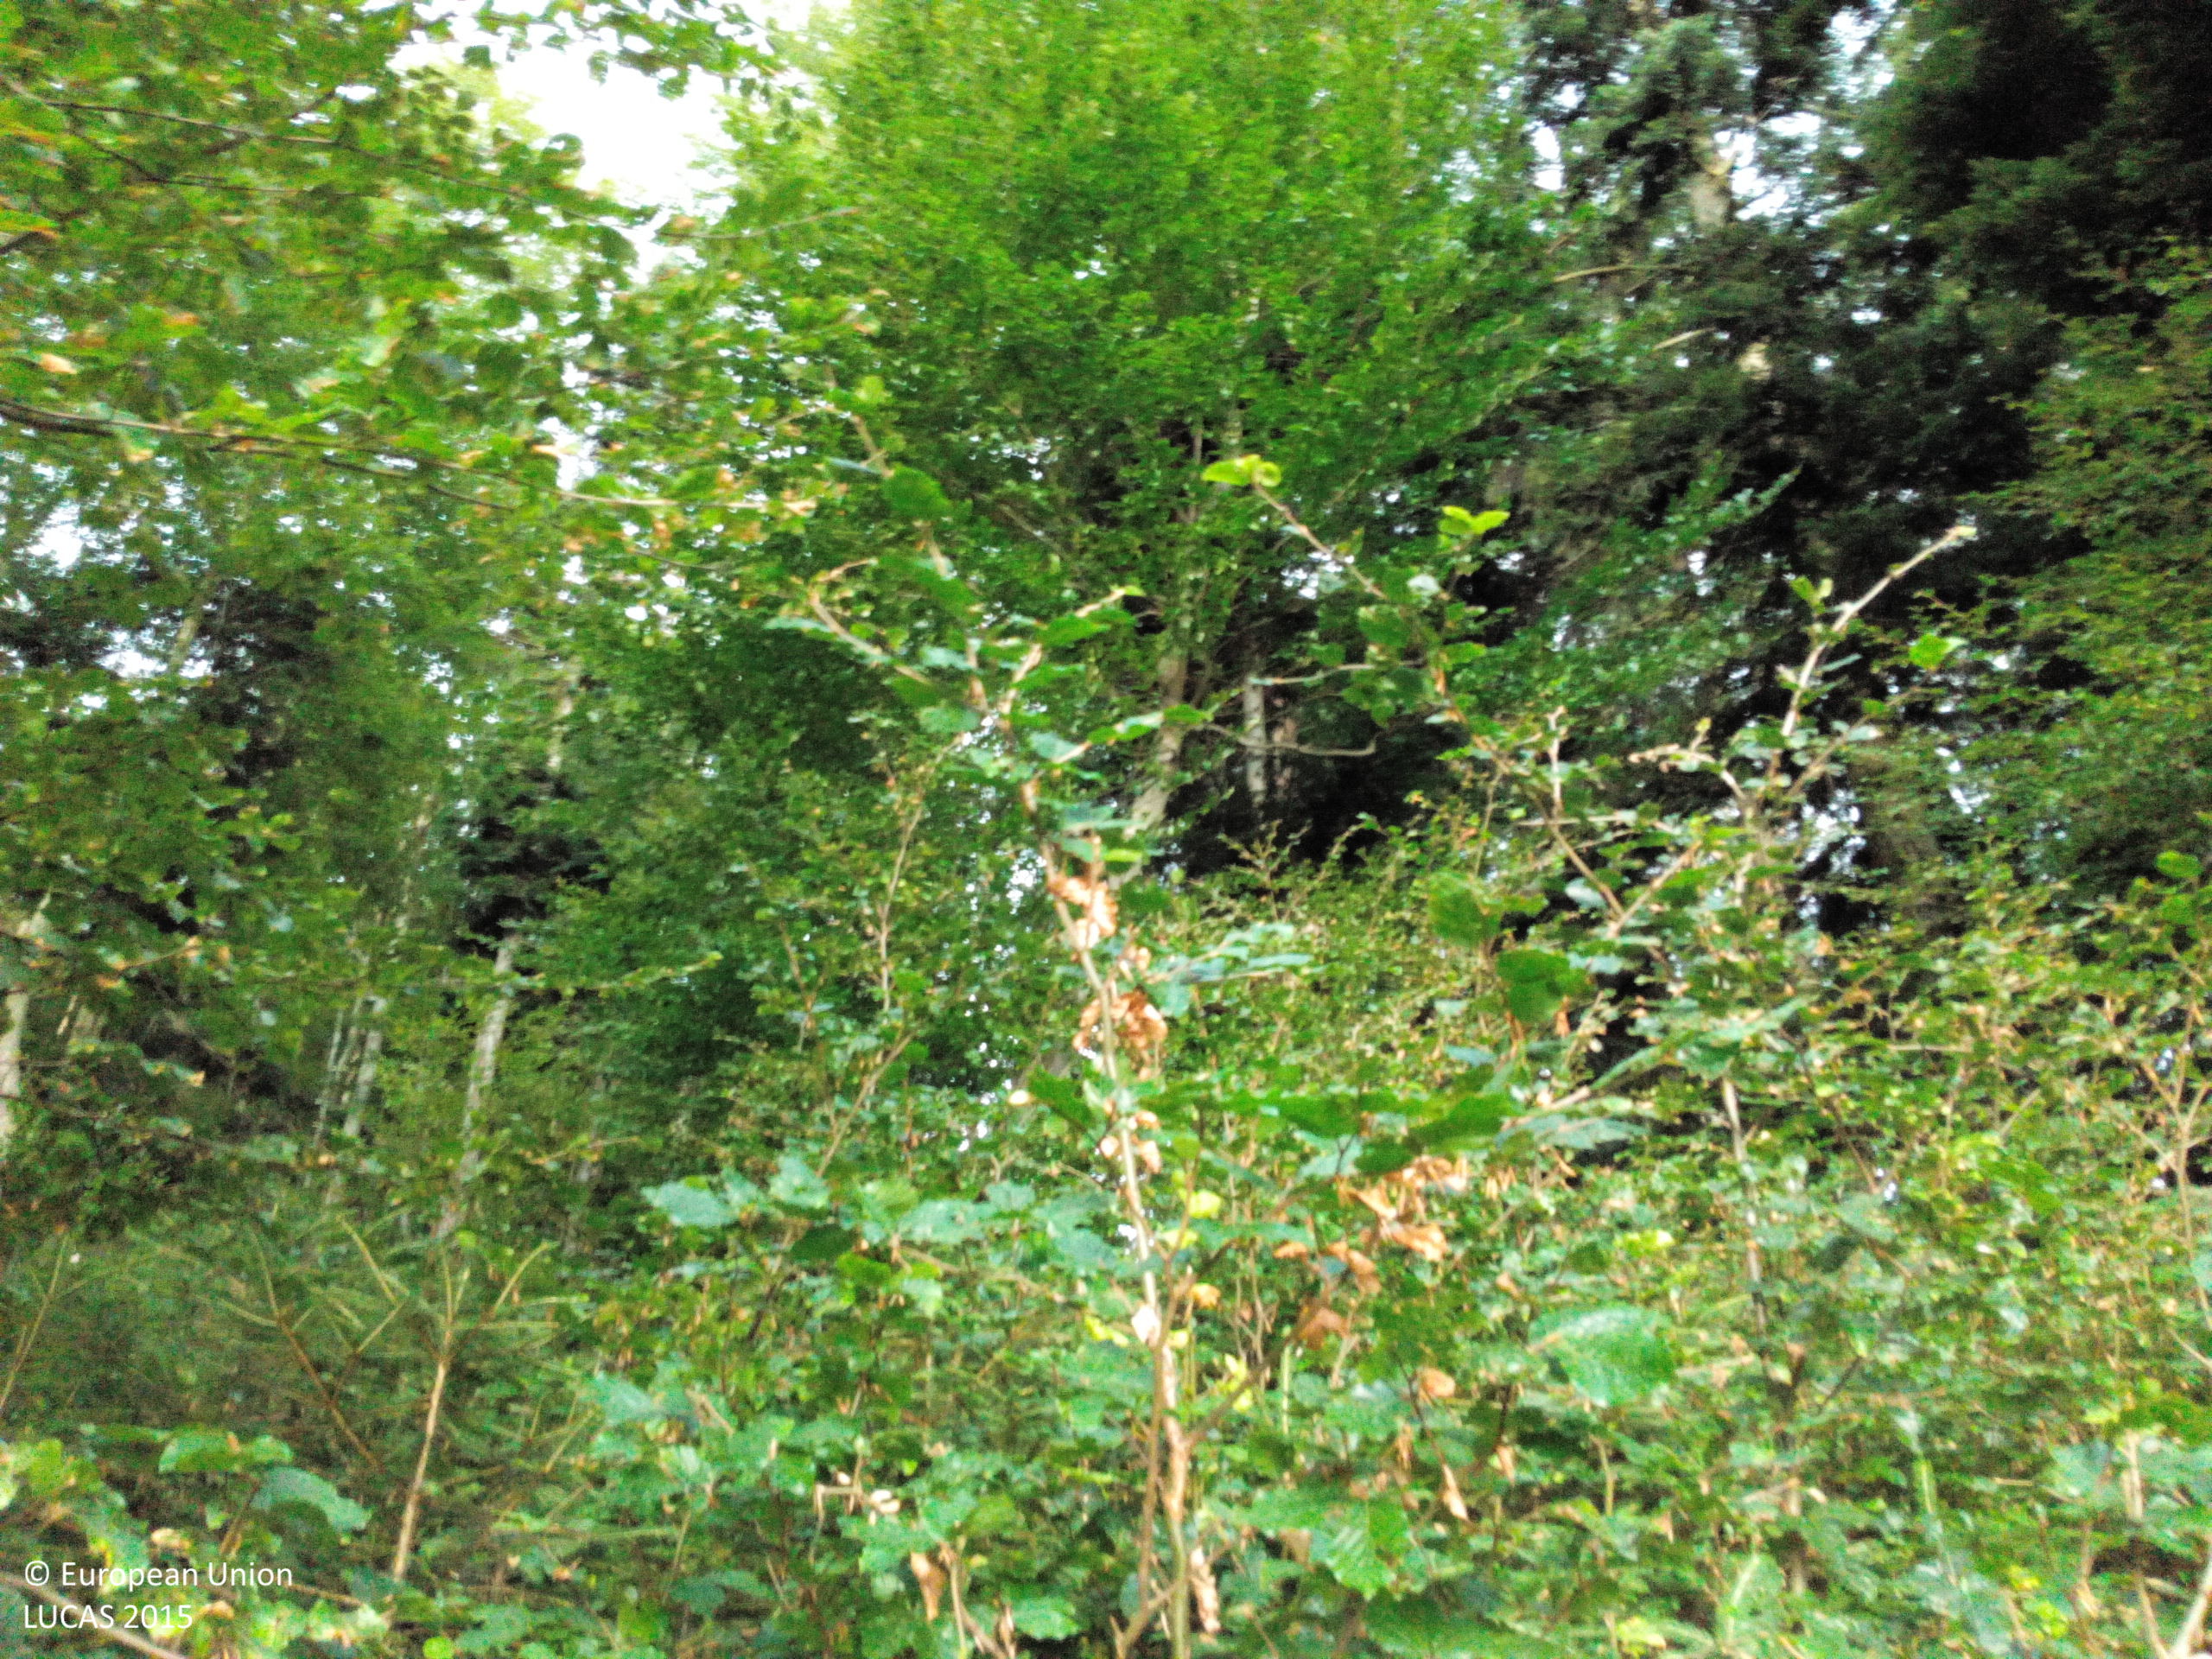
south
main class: Woodland
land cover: Spruce dominated mixed woodland
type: hemiboreal forest and nemoral coniferous forest and mixed broadleaved-coniferous forest
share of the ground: > 75 %
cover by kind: broadleaved forest trees 50 %, coniferous forest trees 35 %, unconsolidated bare surface 10 %, shrubs 5 %
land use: Forestry
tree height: < 5 m
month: July
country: DE
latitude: 48.1353
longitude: 8.1063
